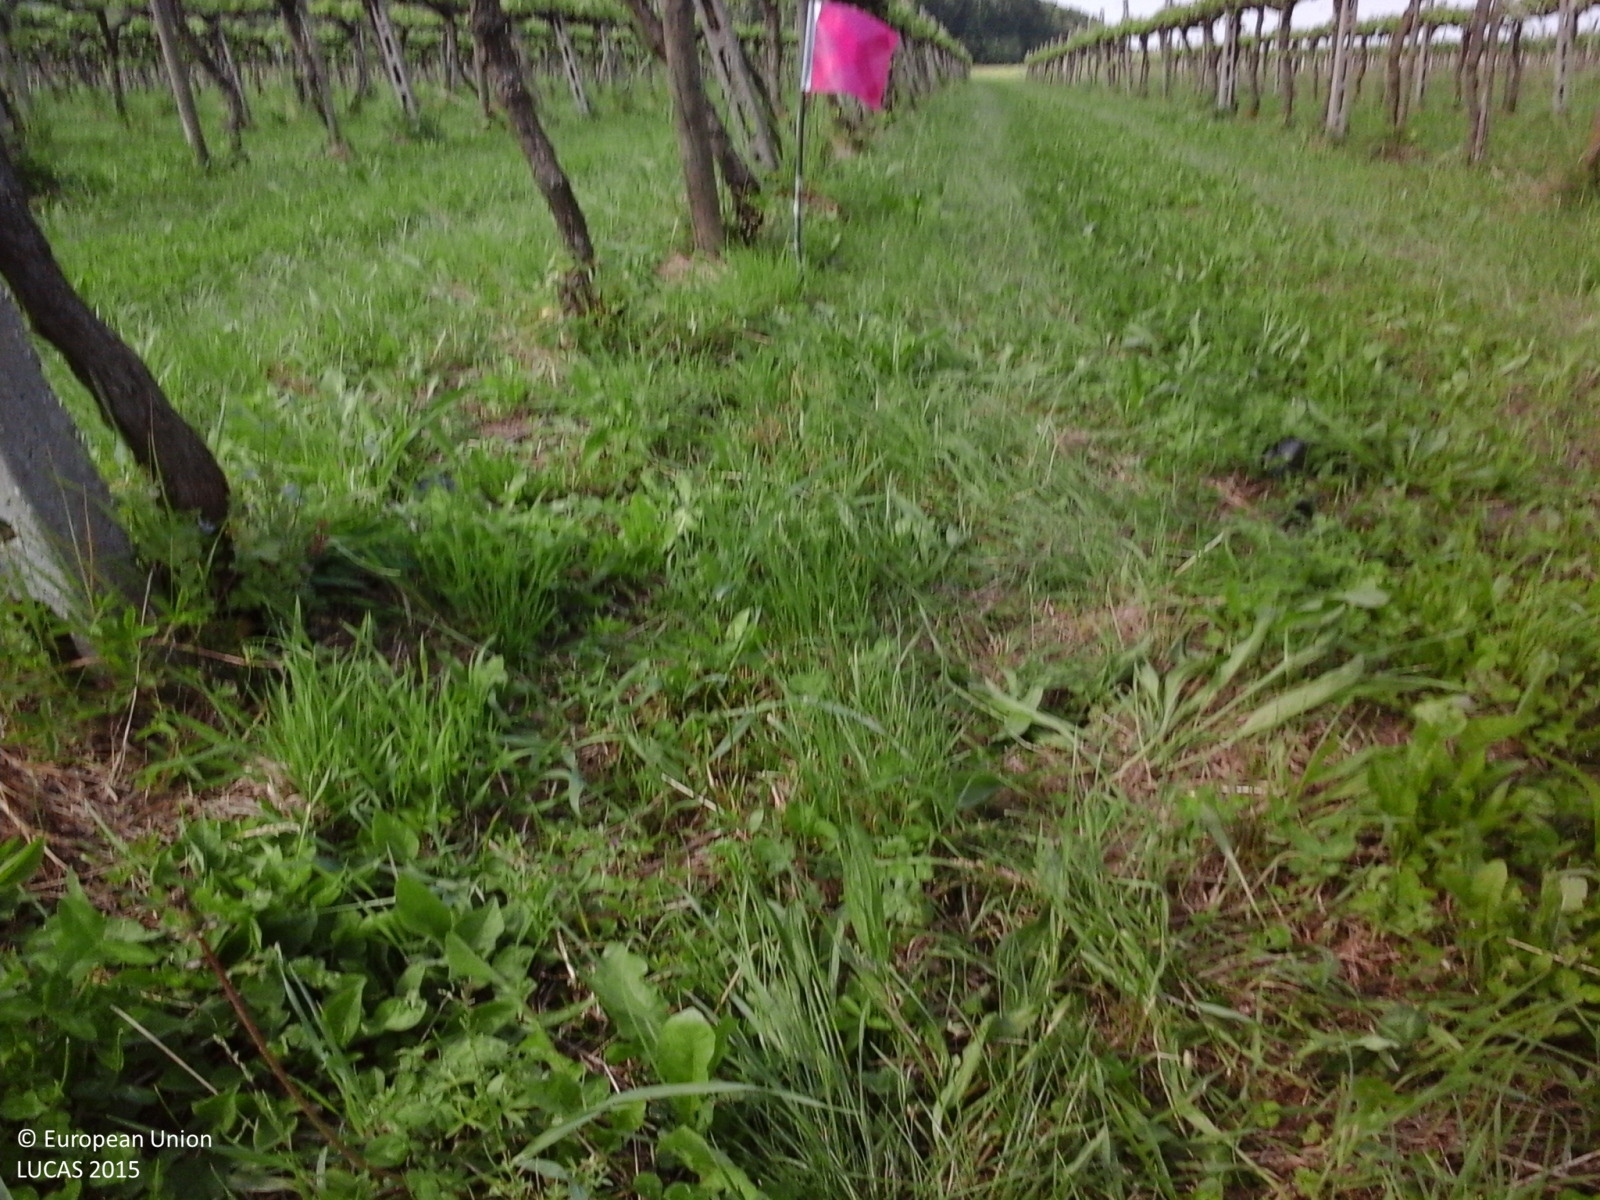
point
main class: Cropland
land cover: Vineyards
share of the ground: > 75 %
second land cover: Grassland without tree/shrub cover
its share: > 75 %
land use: Agriculture (excluding fallow land and kitchen gardens)
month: May
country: IT
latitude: 45.2909
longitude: 11.7947
